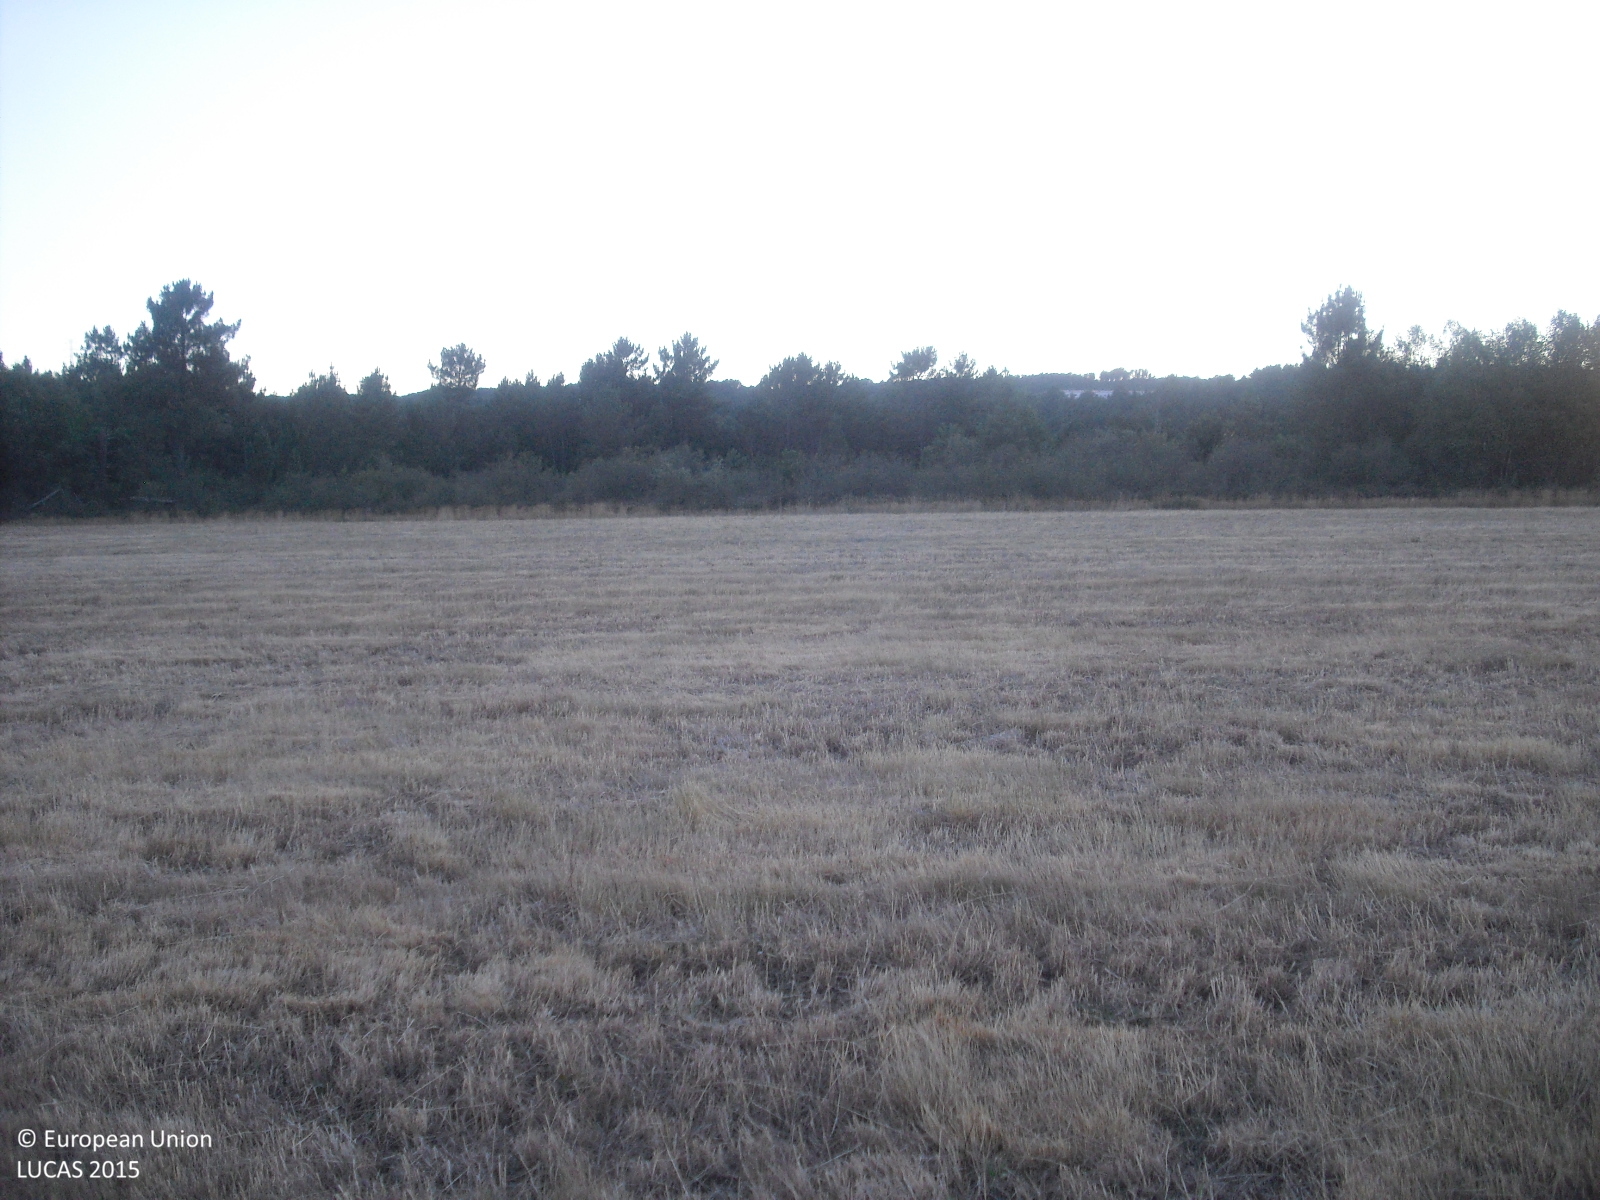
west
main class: Cropland
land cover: Temporary grasslands
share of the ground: > 75 %
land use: Agriculture (excluding fallow land and kitchen gardens)
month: July
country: ES
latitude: 42.2893
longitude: -7.6436
